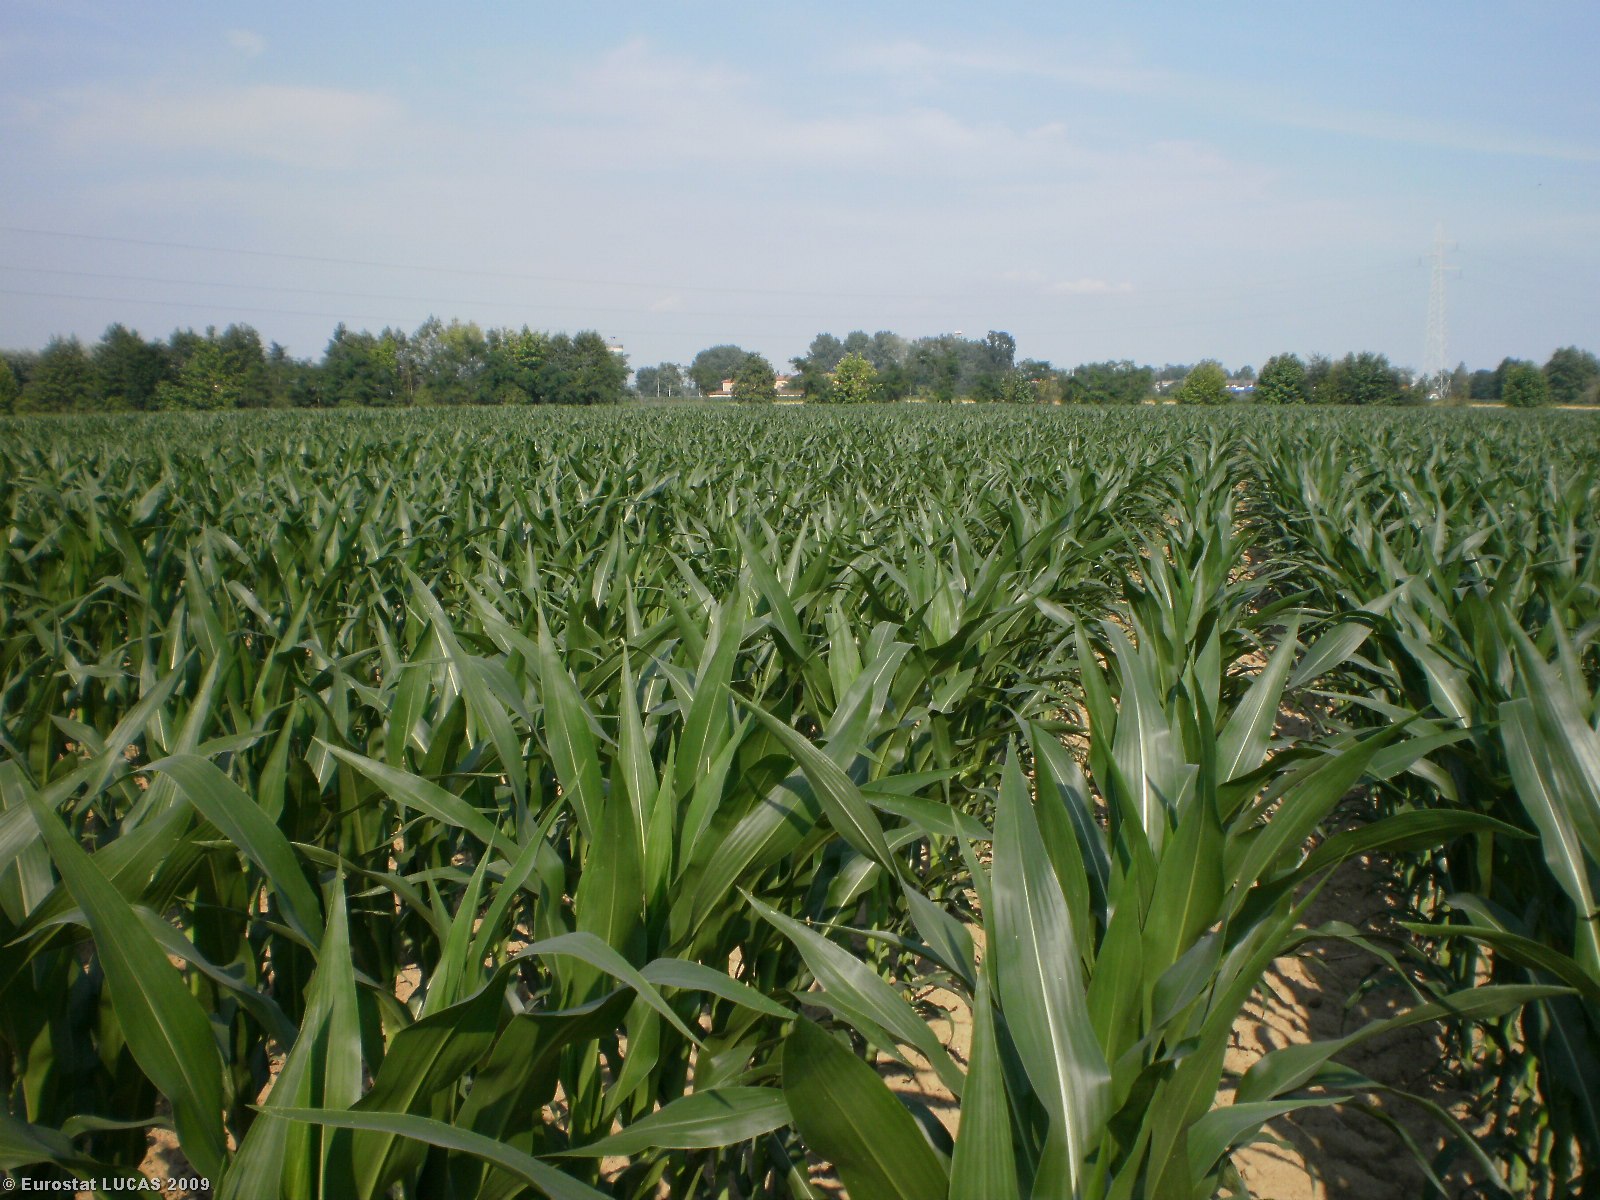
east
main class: Cropland
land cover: Maize
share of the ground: > 75 %
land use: Agriculture (excluding fallow land and kitchen gardens)
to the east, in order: Maize; Shruby margins; Inland running water; Grass margins; Common wheat
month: June
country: IT
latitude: 45.1800
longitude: 10.0381
